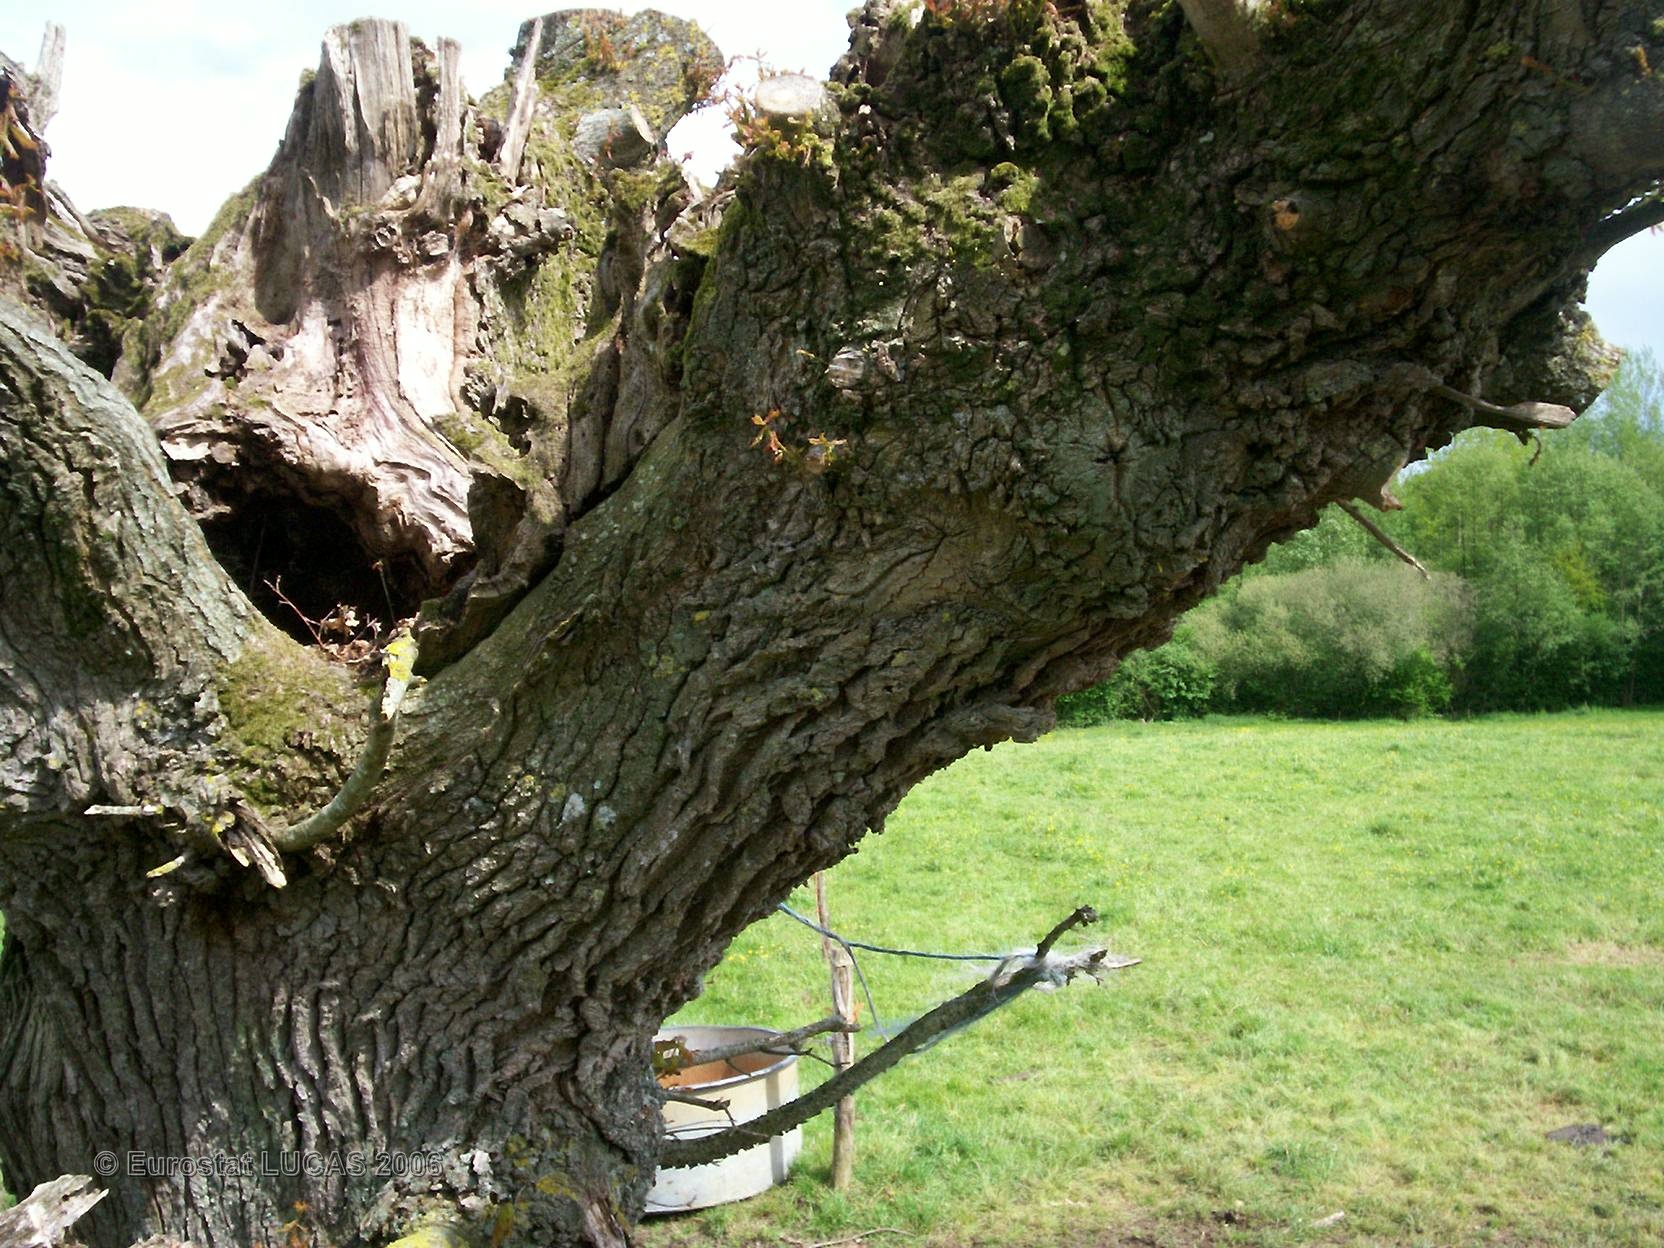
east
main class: Grassland
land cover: Grassland without tree/shrub cover
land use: Agriculture (excluding fallow land and kitchen gardens)
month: May
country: FR
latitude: 46.5995
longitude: -0.2722
